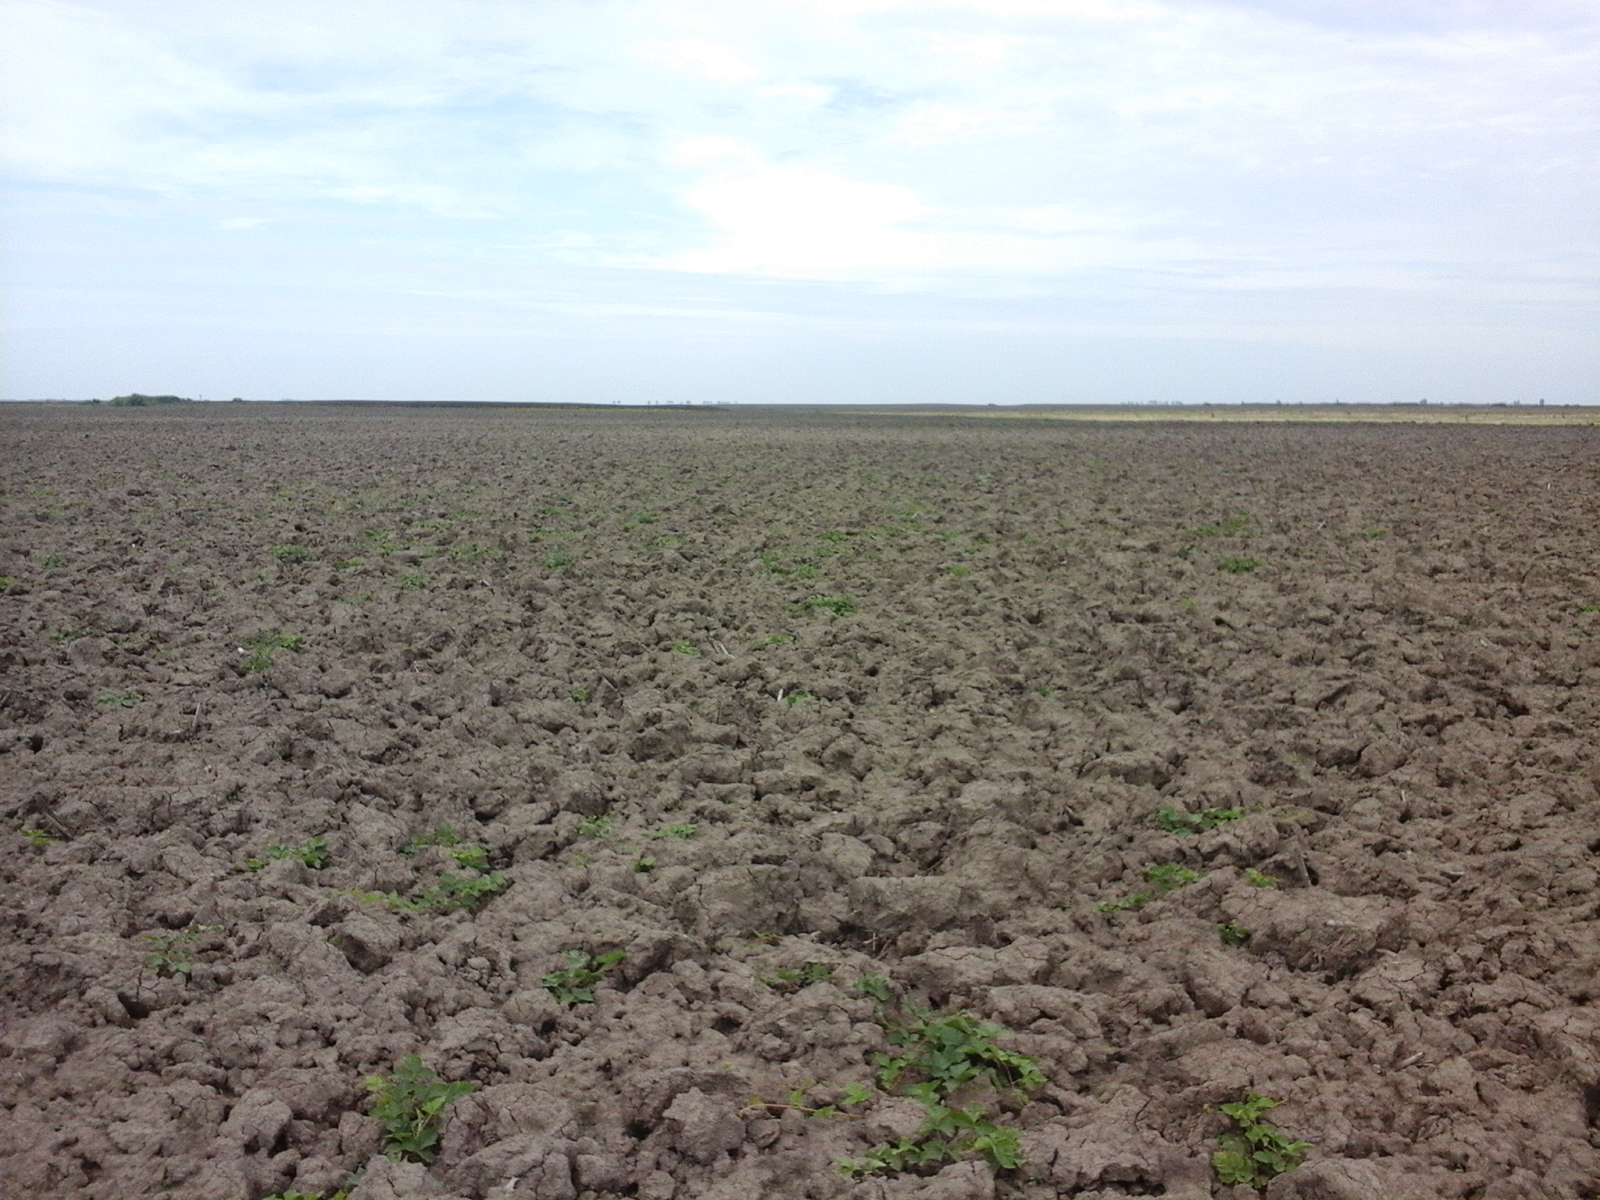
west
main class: Cropland
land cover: Common wheat
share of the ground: < 10 %
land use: Agriculture (excluding fallow land and kitchen gardens)
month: August
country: RO
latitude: 46.3524
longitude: 21.6172
